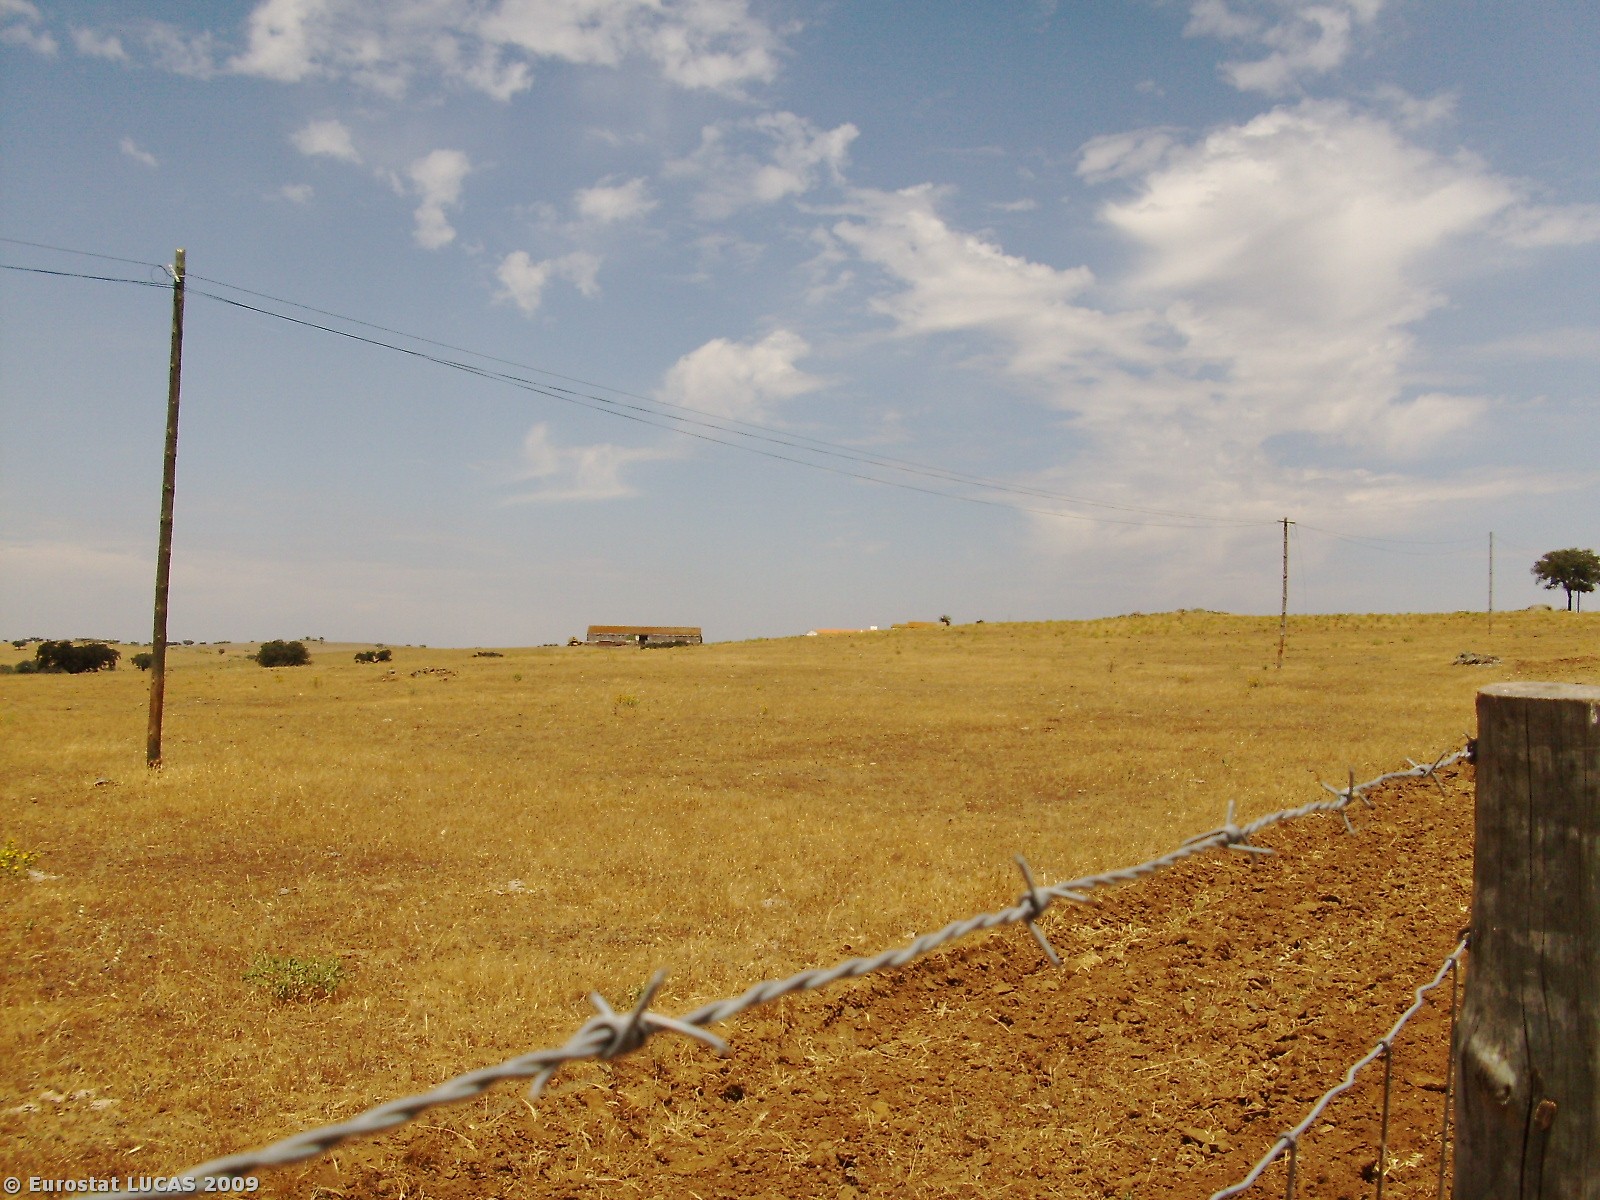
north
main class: Grassland
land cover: Spontaneously vegetated surfaces
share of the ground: > 75 %
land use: Fallow land
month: June
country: PT
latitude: 39.1195
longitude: -7.4221
